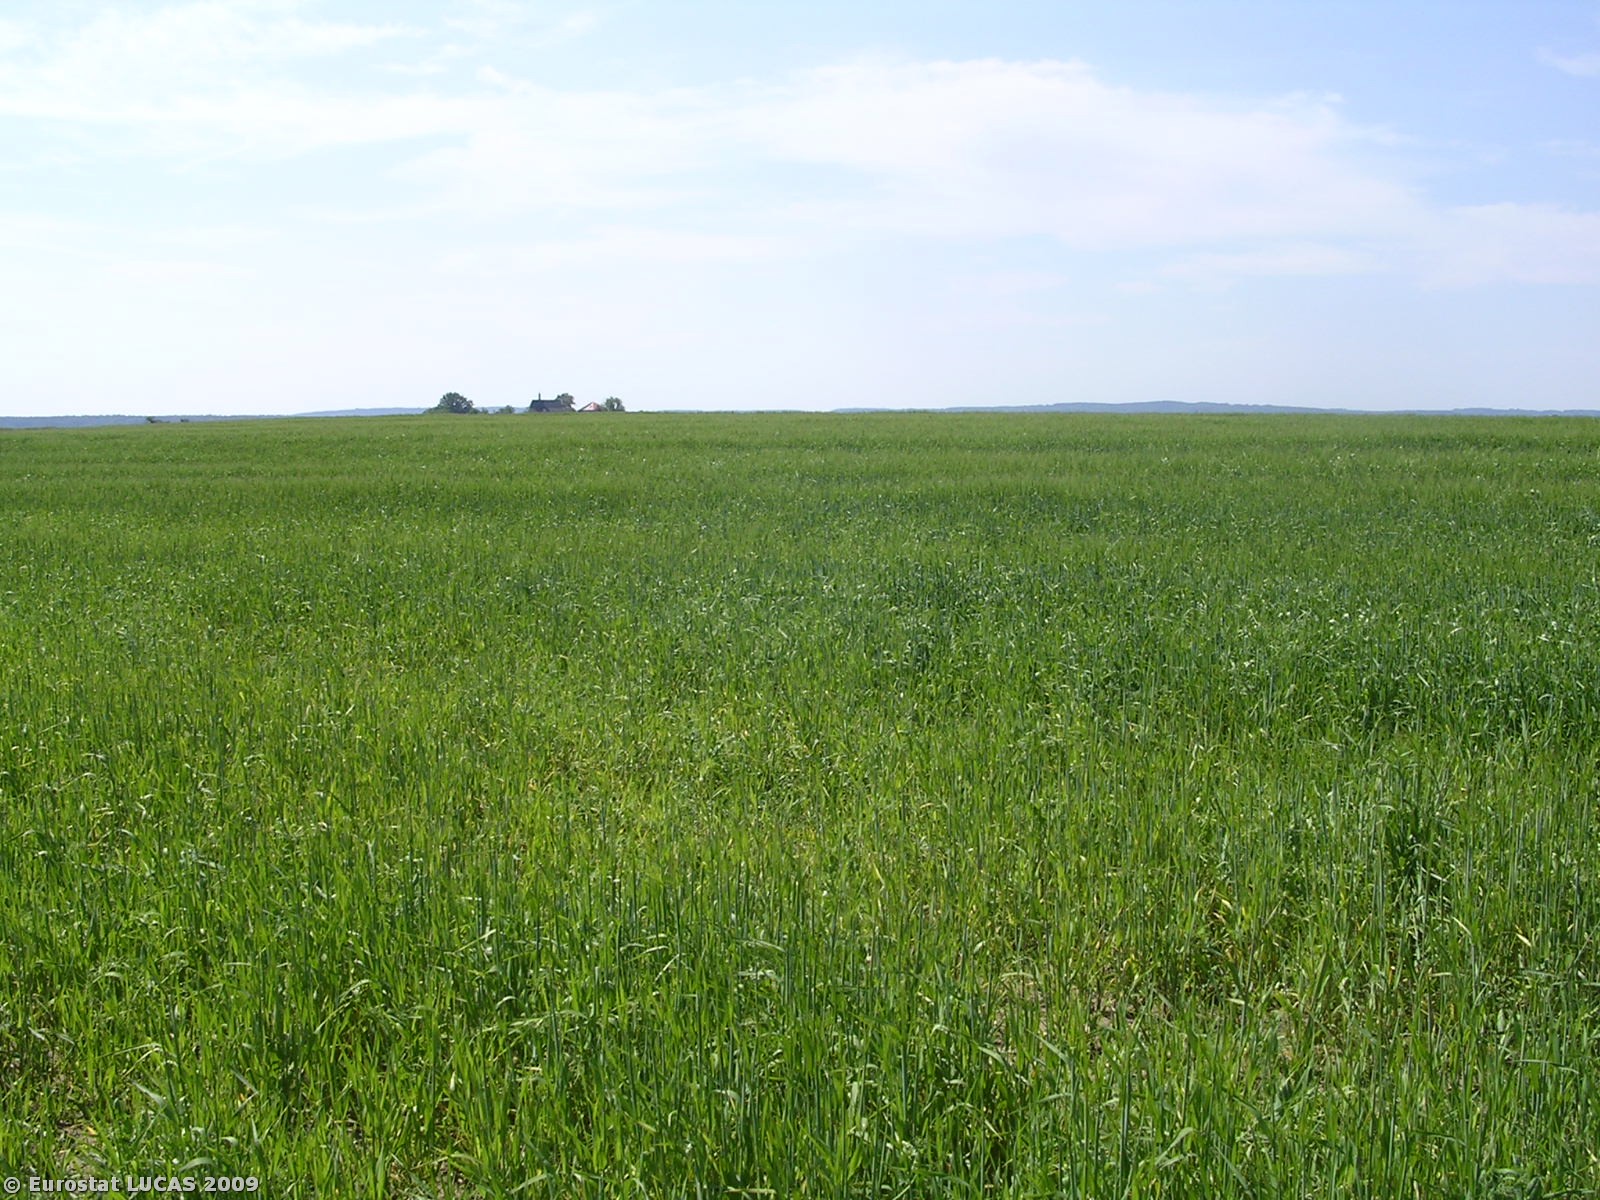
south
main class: Cropland
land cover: Barley
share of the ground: > 75 %
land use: Agriculture (excluding fallow land and kitchen gardens)
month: June
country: CZ
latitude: 50.4683
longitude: 15.0609
